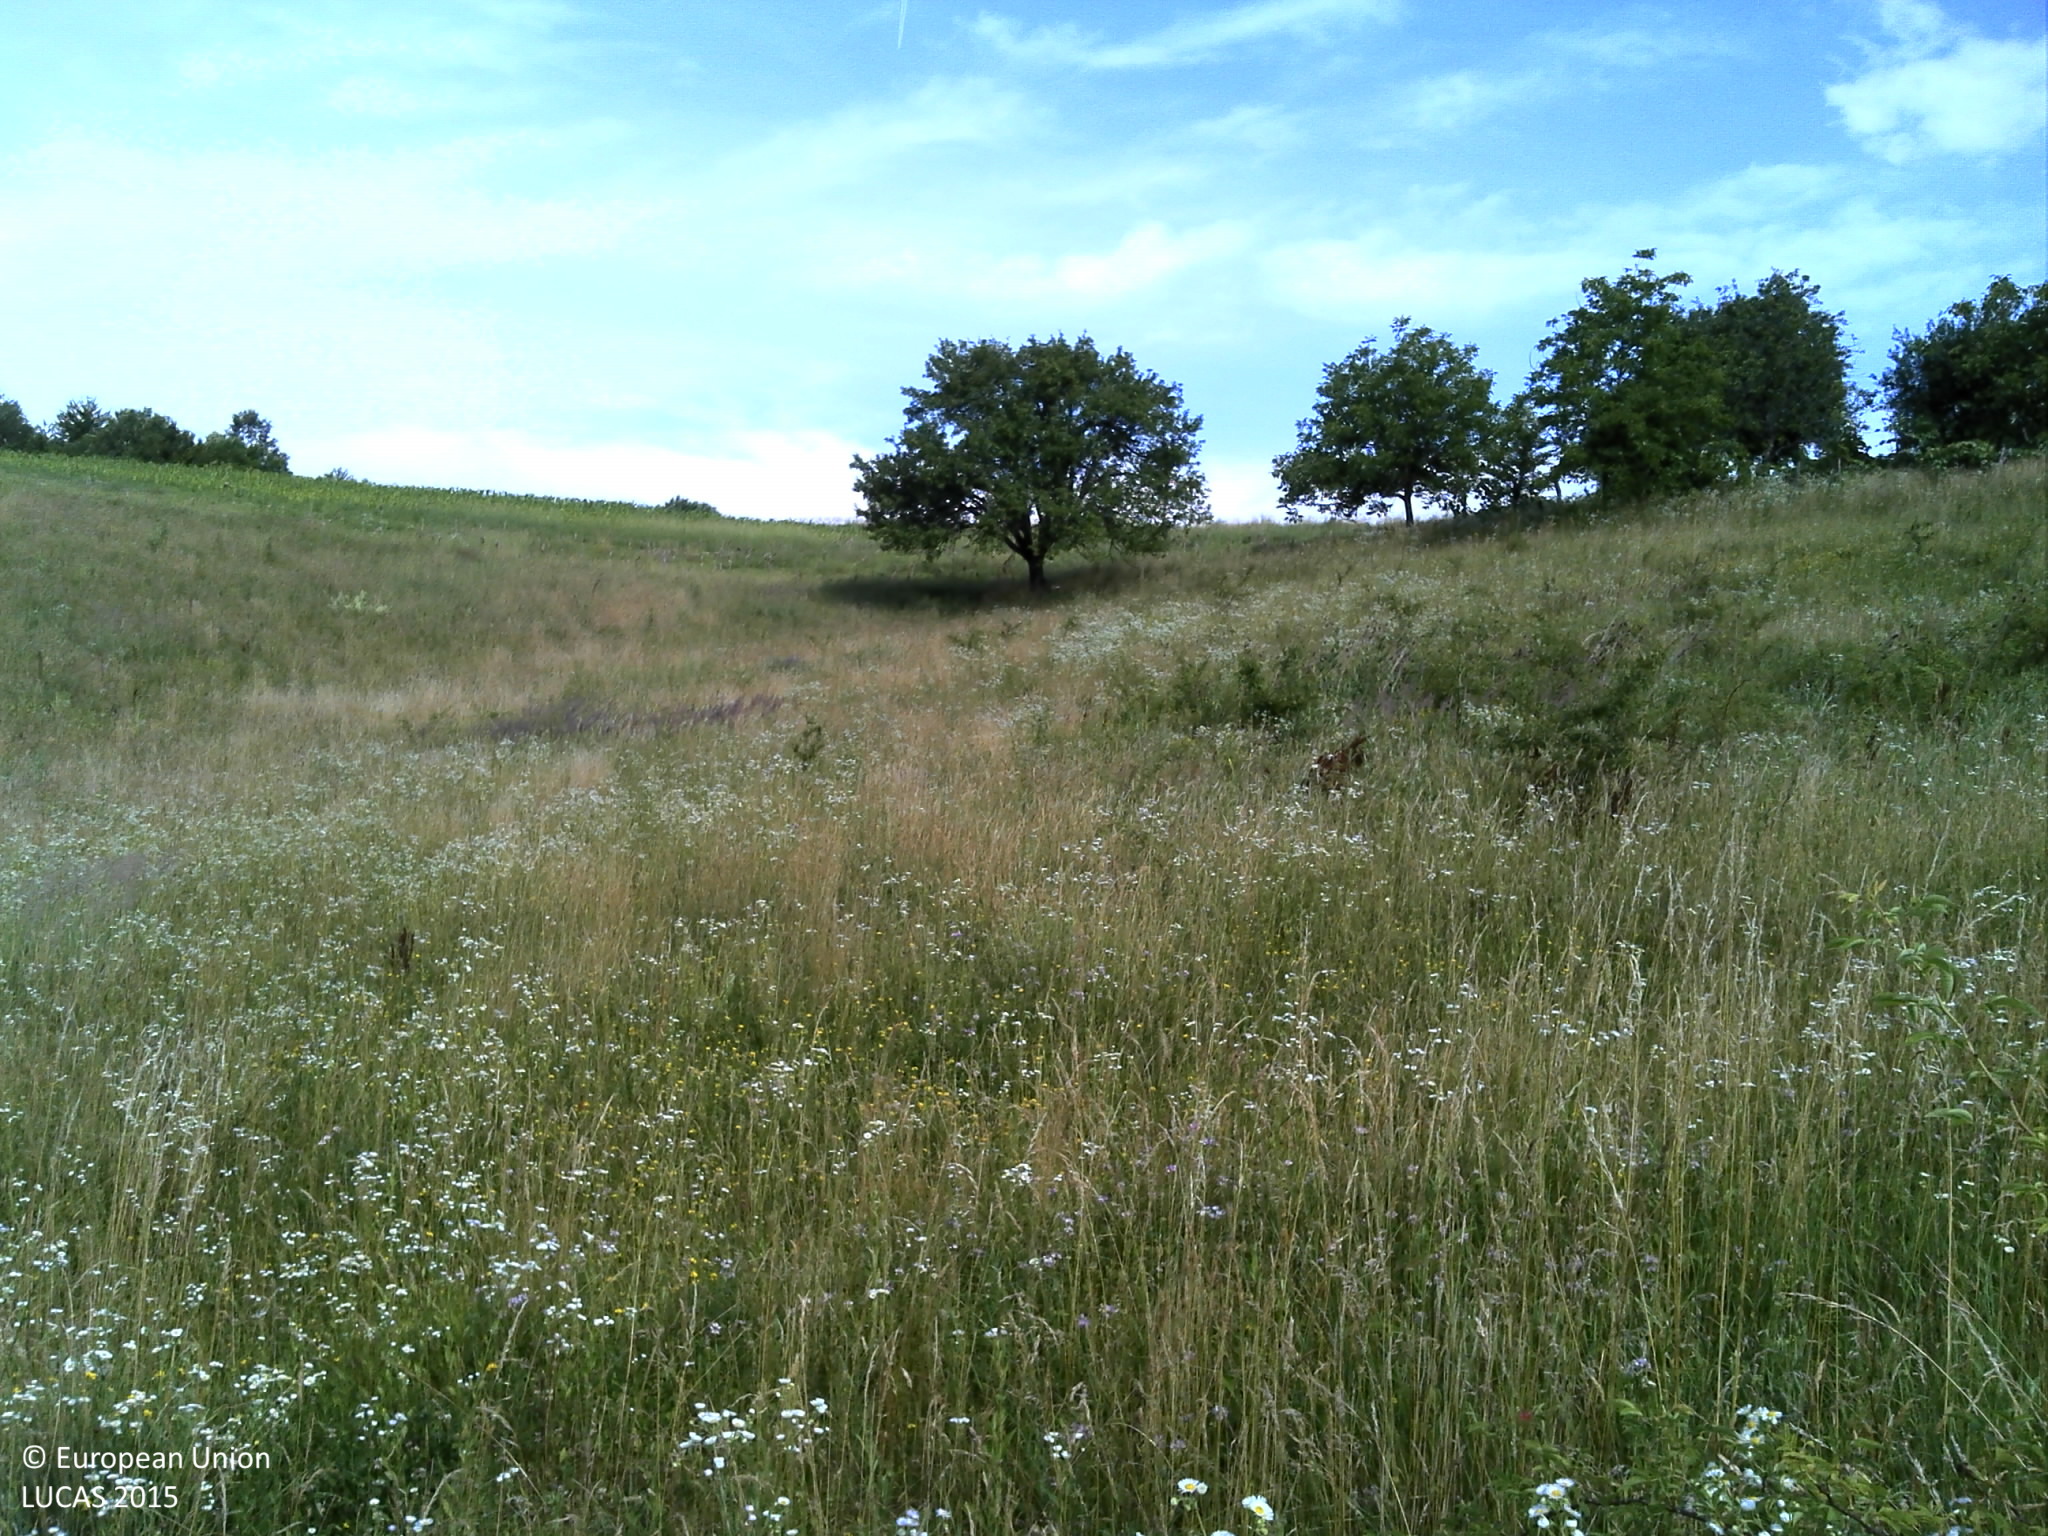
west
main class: Grassland
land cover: Spontaneously vegetated surfaces
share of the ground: > 75 %
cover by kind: herbaceous plants 100 %
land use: Fallow land
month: June
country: HR
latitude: 45.7067
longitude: 17.5165
